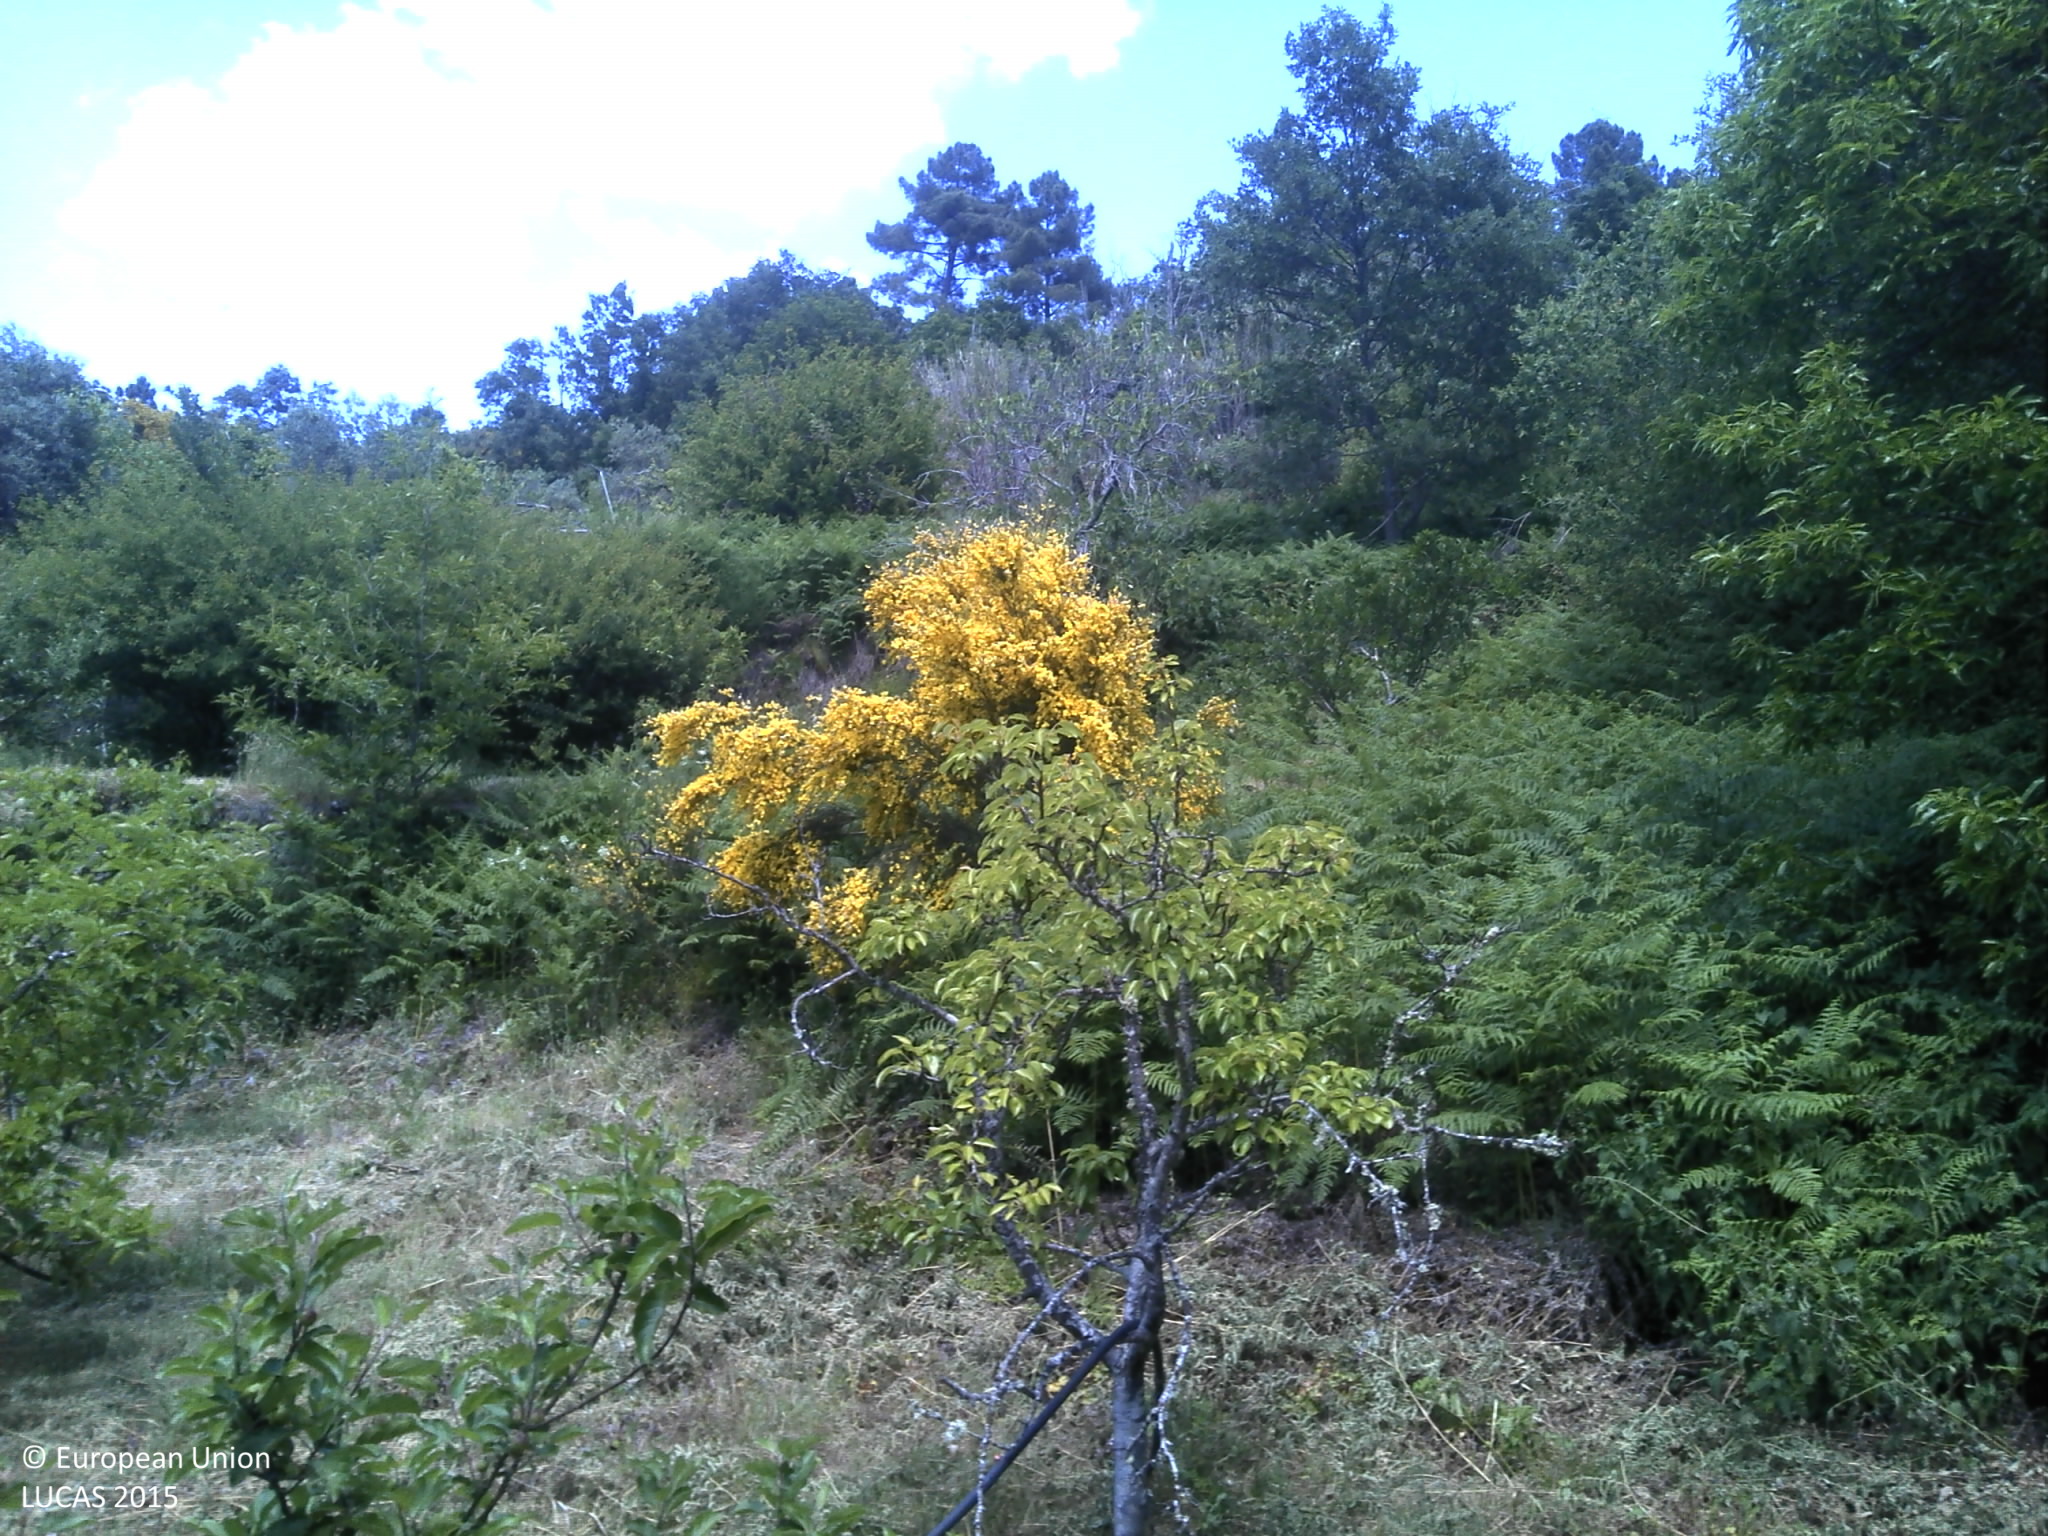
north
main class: Woodland
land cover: Broadleaved woodland
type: thermophilous deciduous forest
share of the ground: 25 - 50 %
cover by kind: shrubs 50 %, broadleaved forest trees 25 %, unconsolidated bare surface 25 %
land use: Forestry
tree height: > 5 m
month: May
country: PT
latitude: 40.4798
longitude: -7.2442
